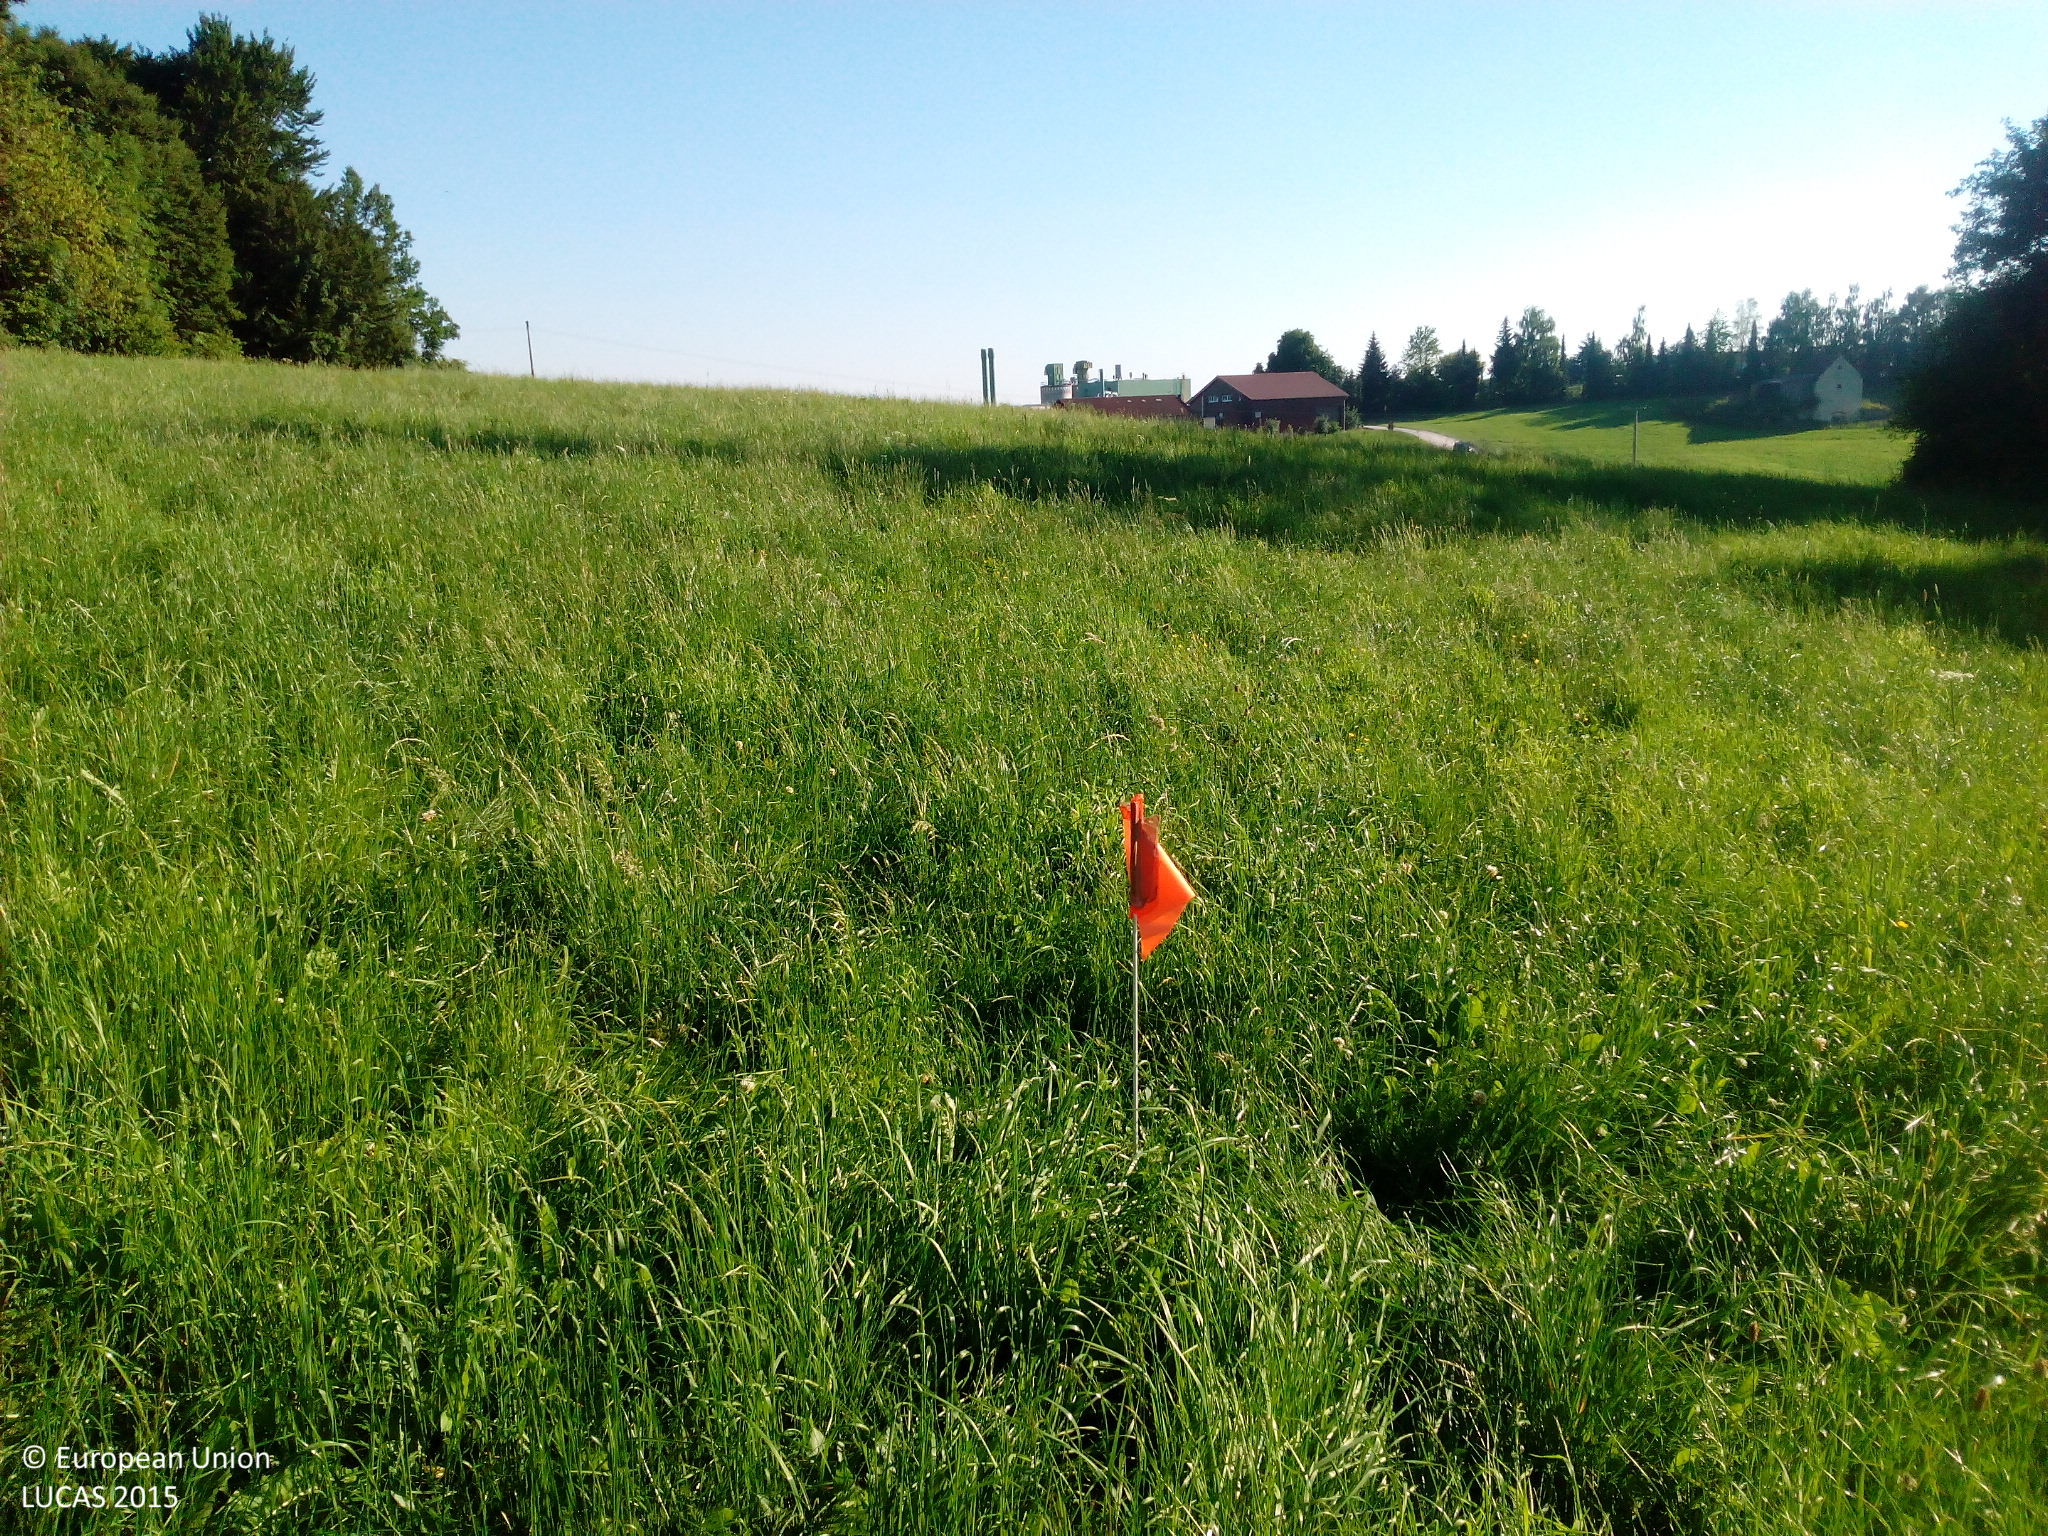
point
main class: Grassland
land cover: Grassland without tree/shrub cover
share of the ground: > 75 %
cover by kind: herbaceous plants 100 %
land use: Agriculture (excluding fallow land and kitchen gardens)
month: July
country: DE
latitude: 48.3295
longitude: 9.3394
